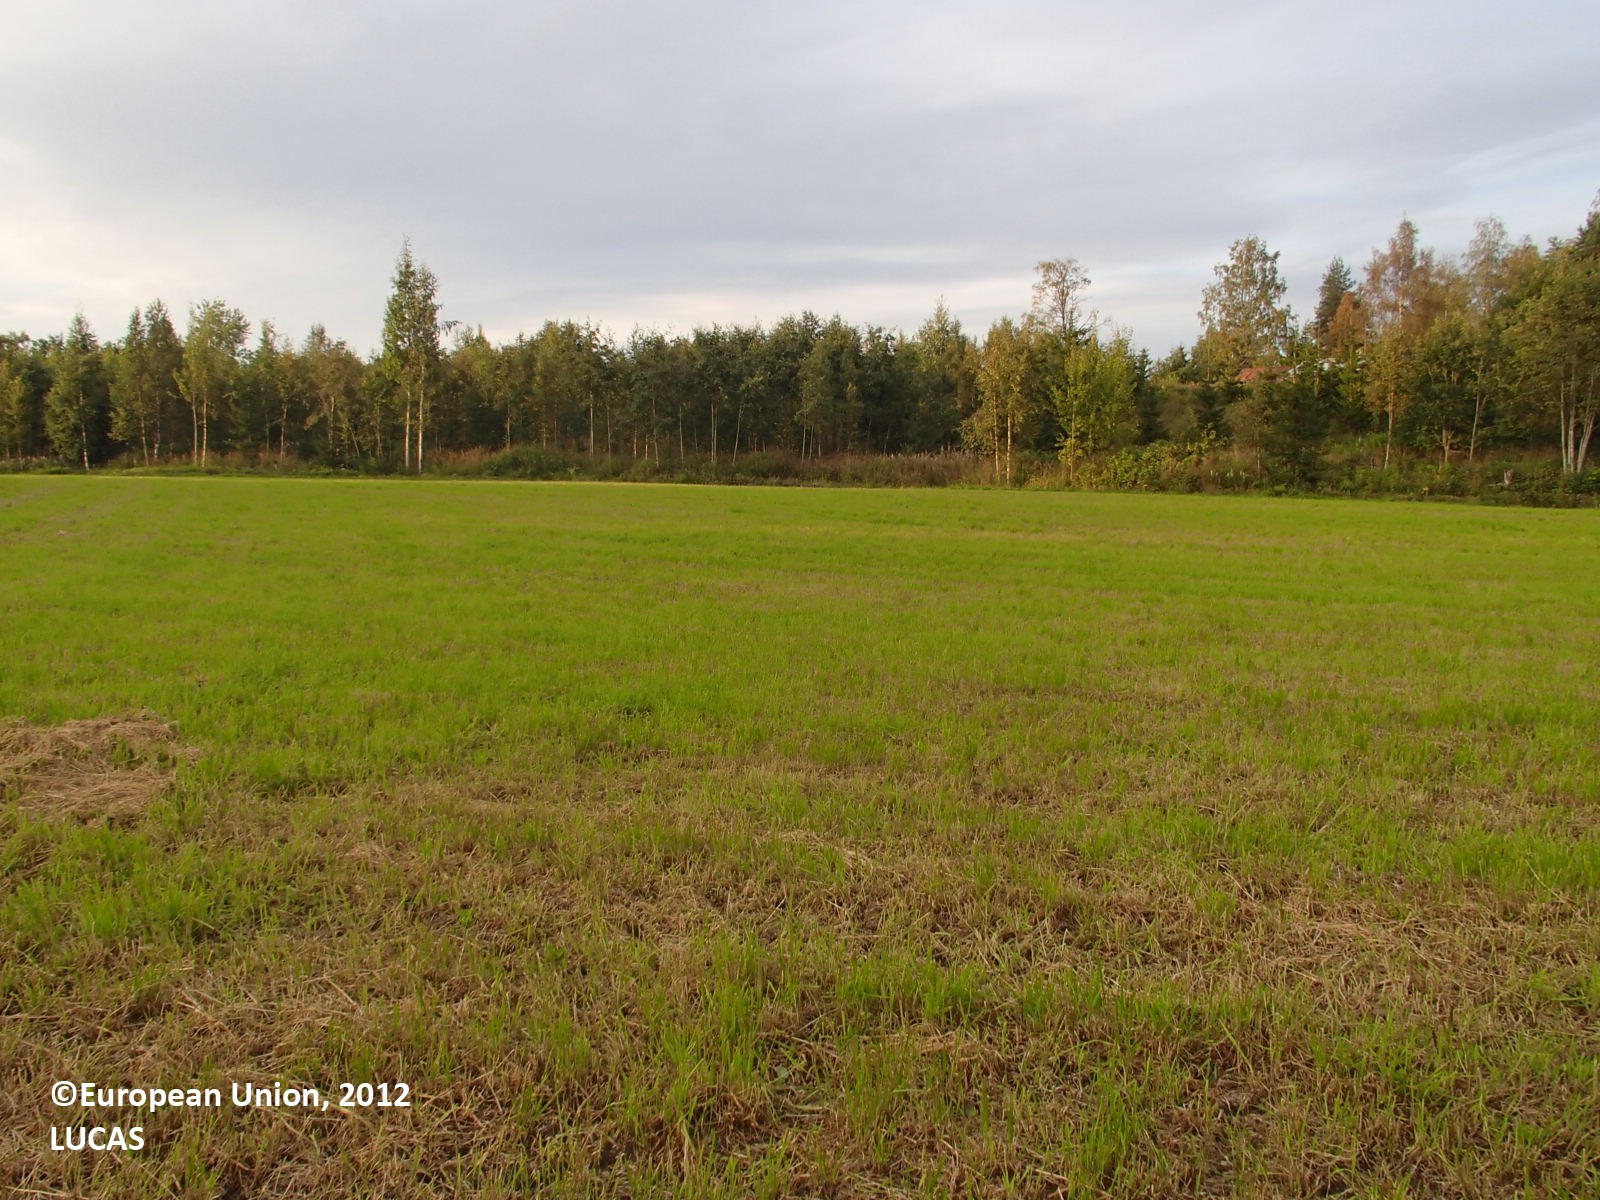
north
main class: Cropland
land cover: Temporary grasslands
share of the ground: > 75 %
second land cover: Barley
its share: < 10 %
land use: Agriculture (excluding fallow land and kitchen gardens)
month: August
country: FI
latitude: 63.3740
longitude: 27.9932
